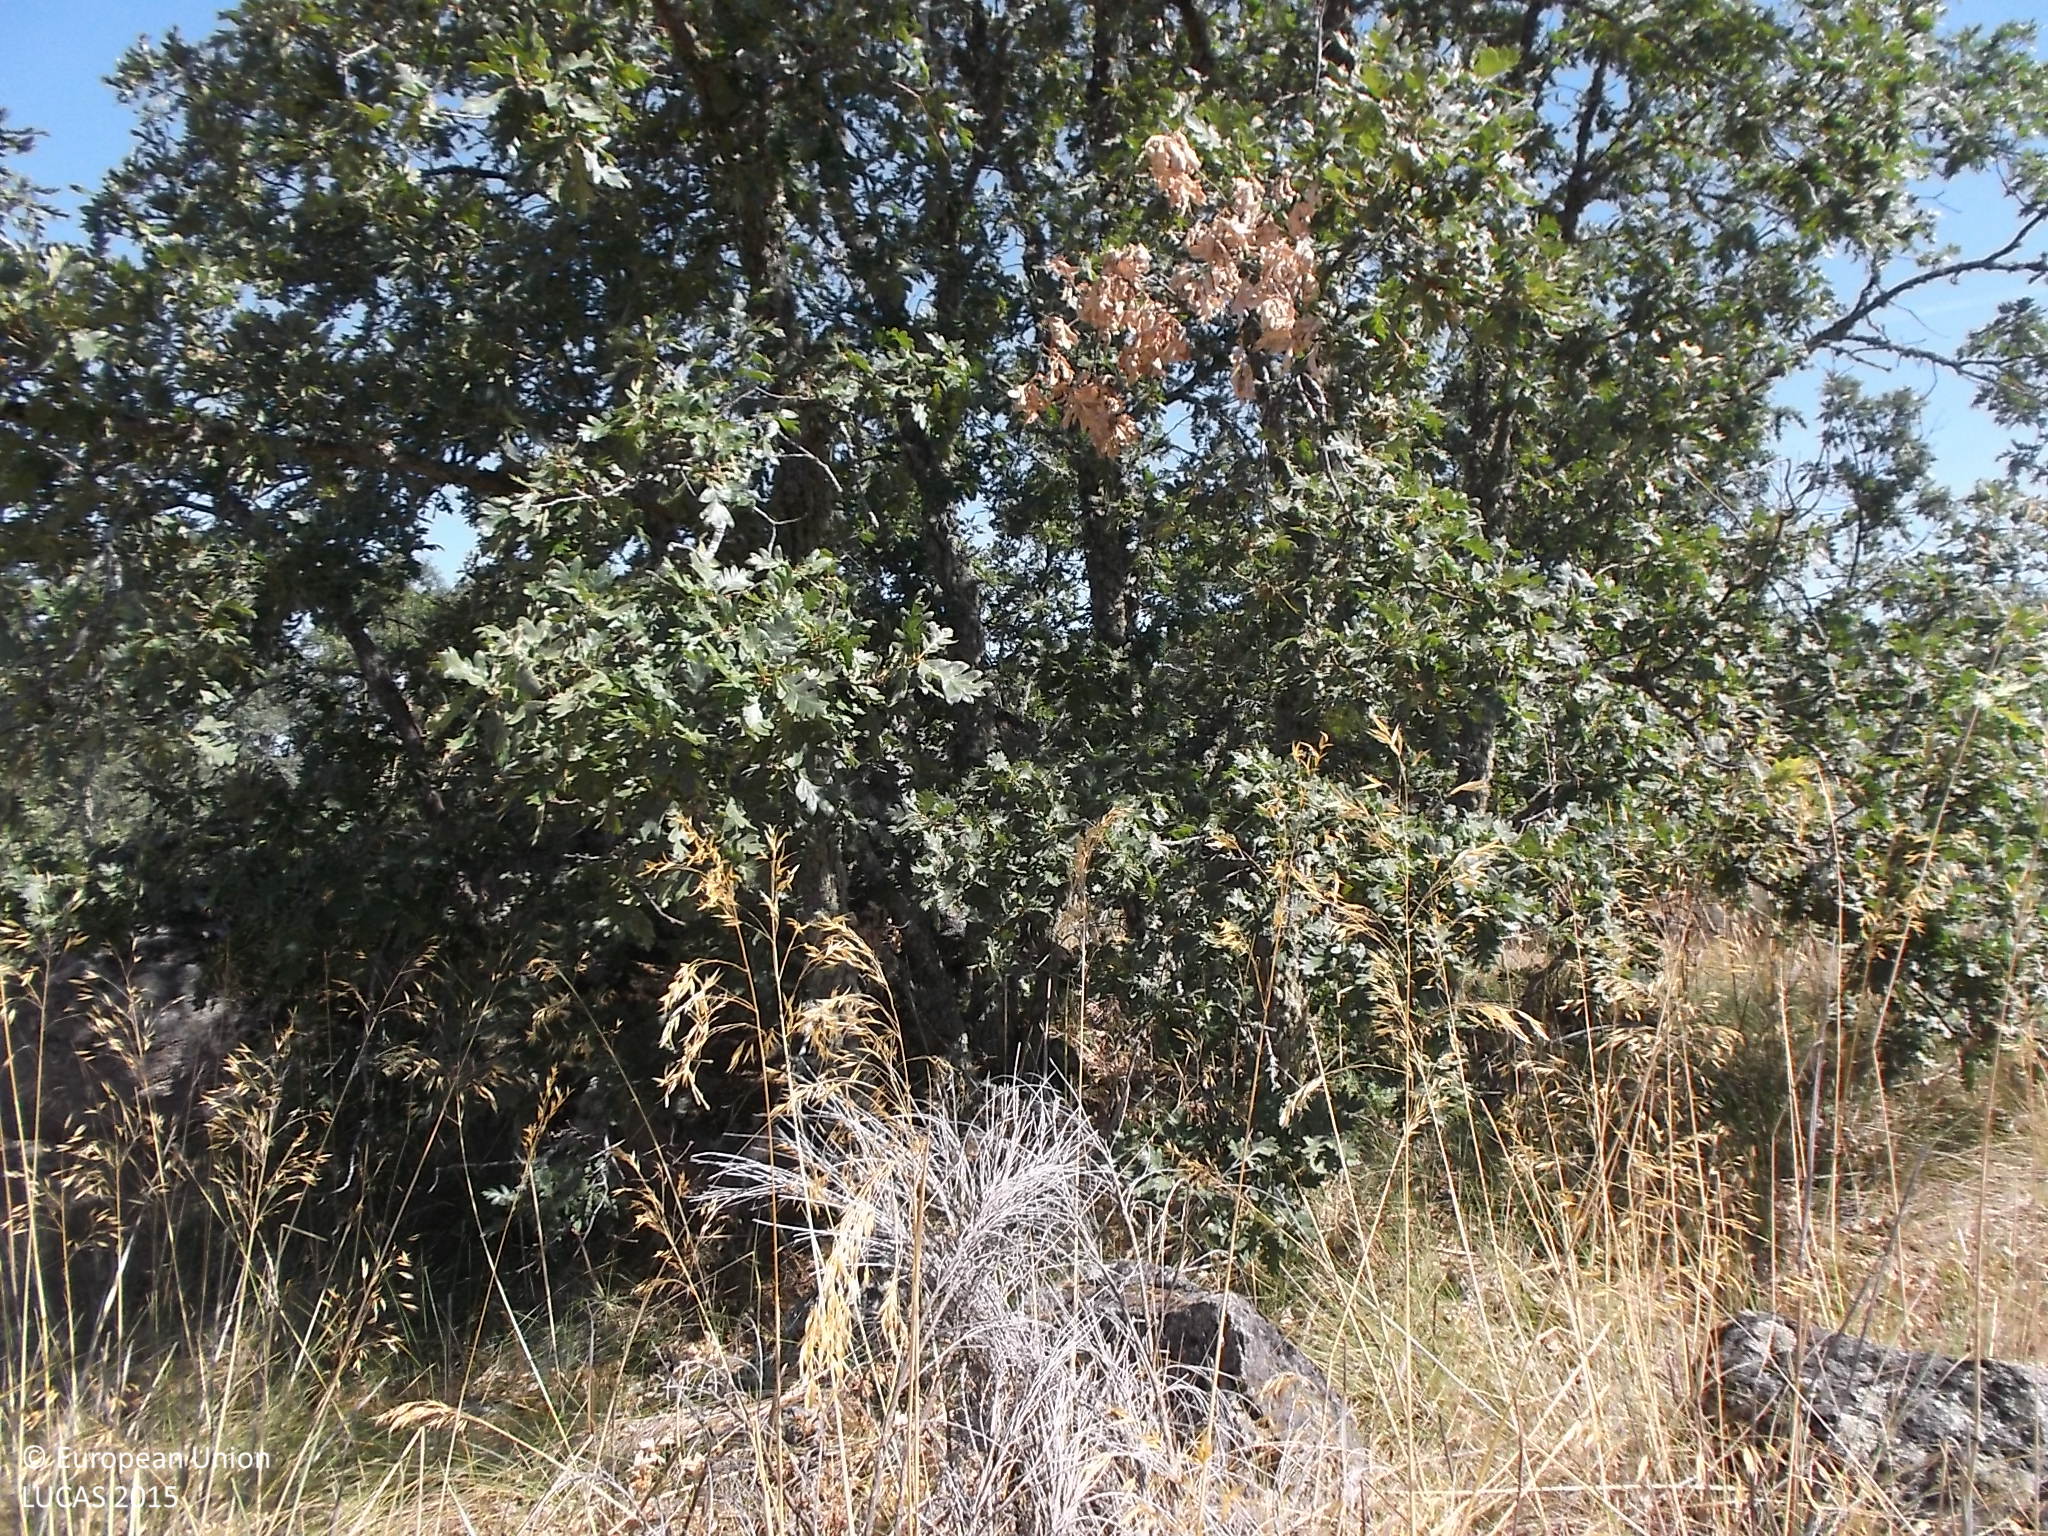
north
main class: Shrubland
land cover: Shrubland with sparse tree cover
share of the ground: > 75 %
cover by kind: shrubs 80 %, herbaceous plants 15 %, broadleaved forest trees 5 %
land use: Agriculture (excluding fallow land and kitchen gardens)
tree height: < 5 m
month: July
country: ES
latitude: 41.2203
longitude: -6.4756
